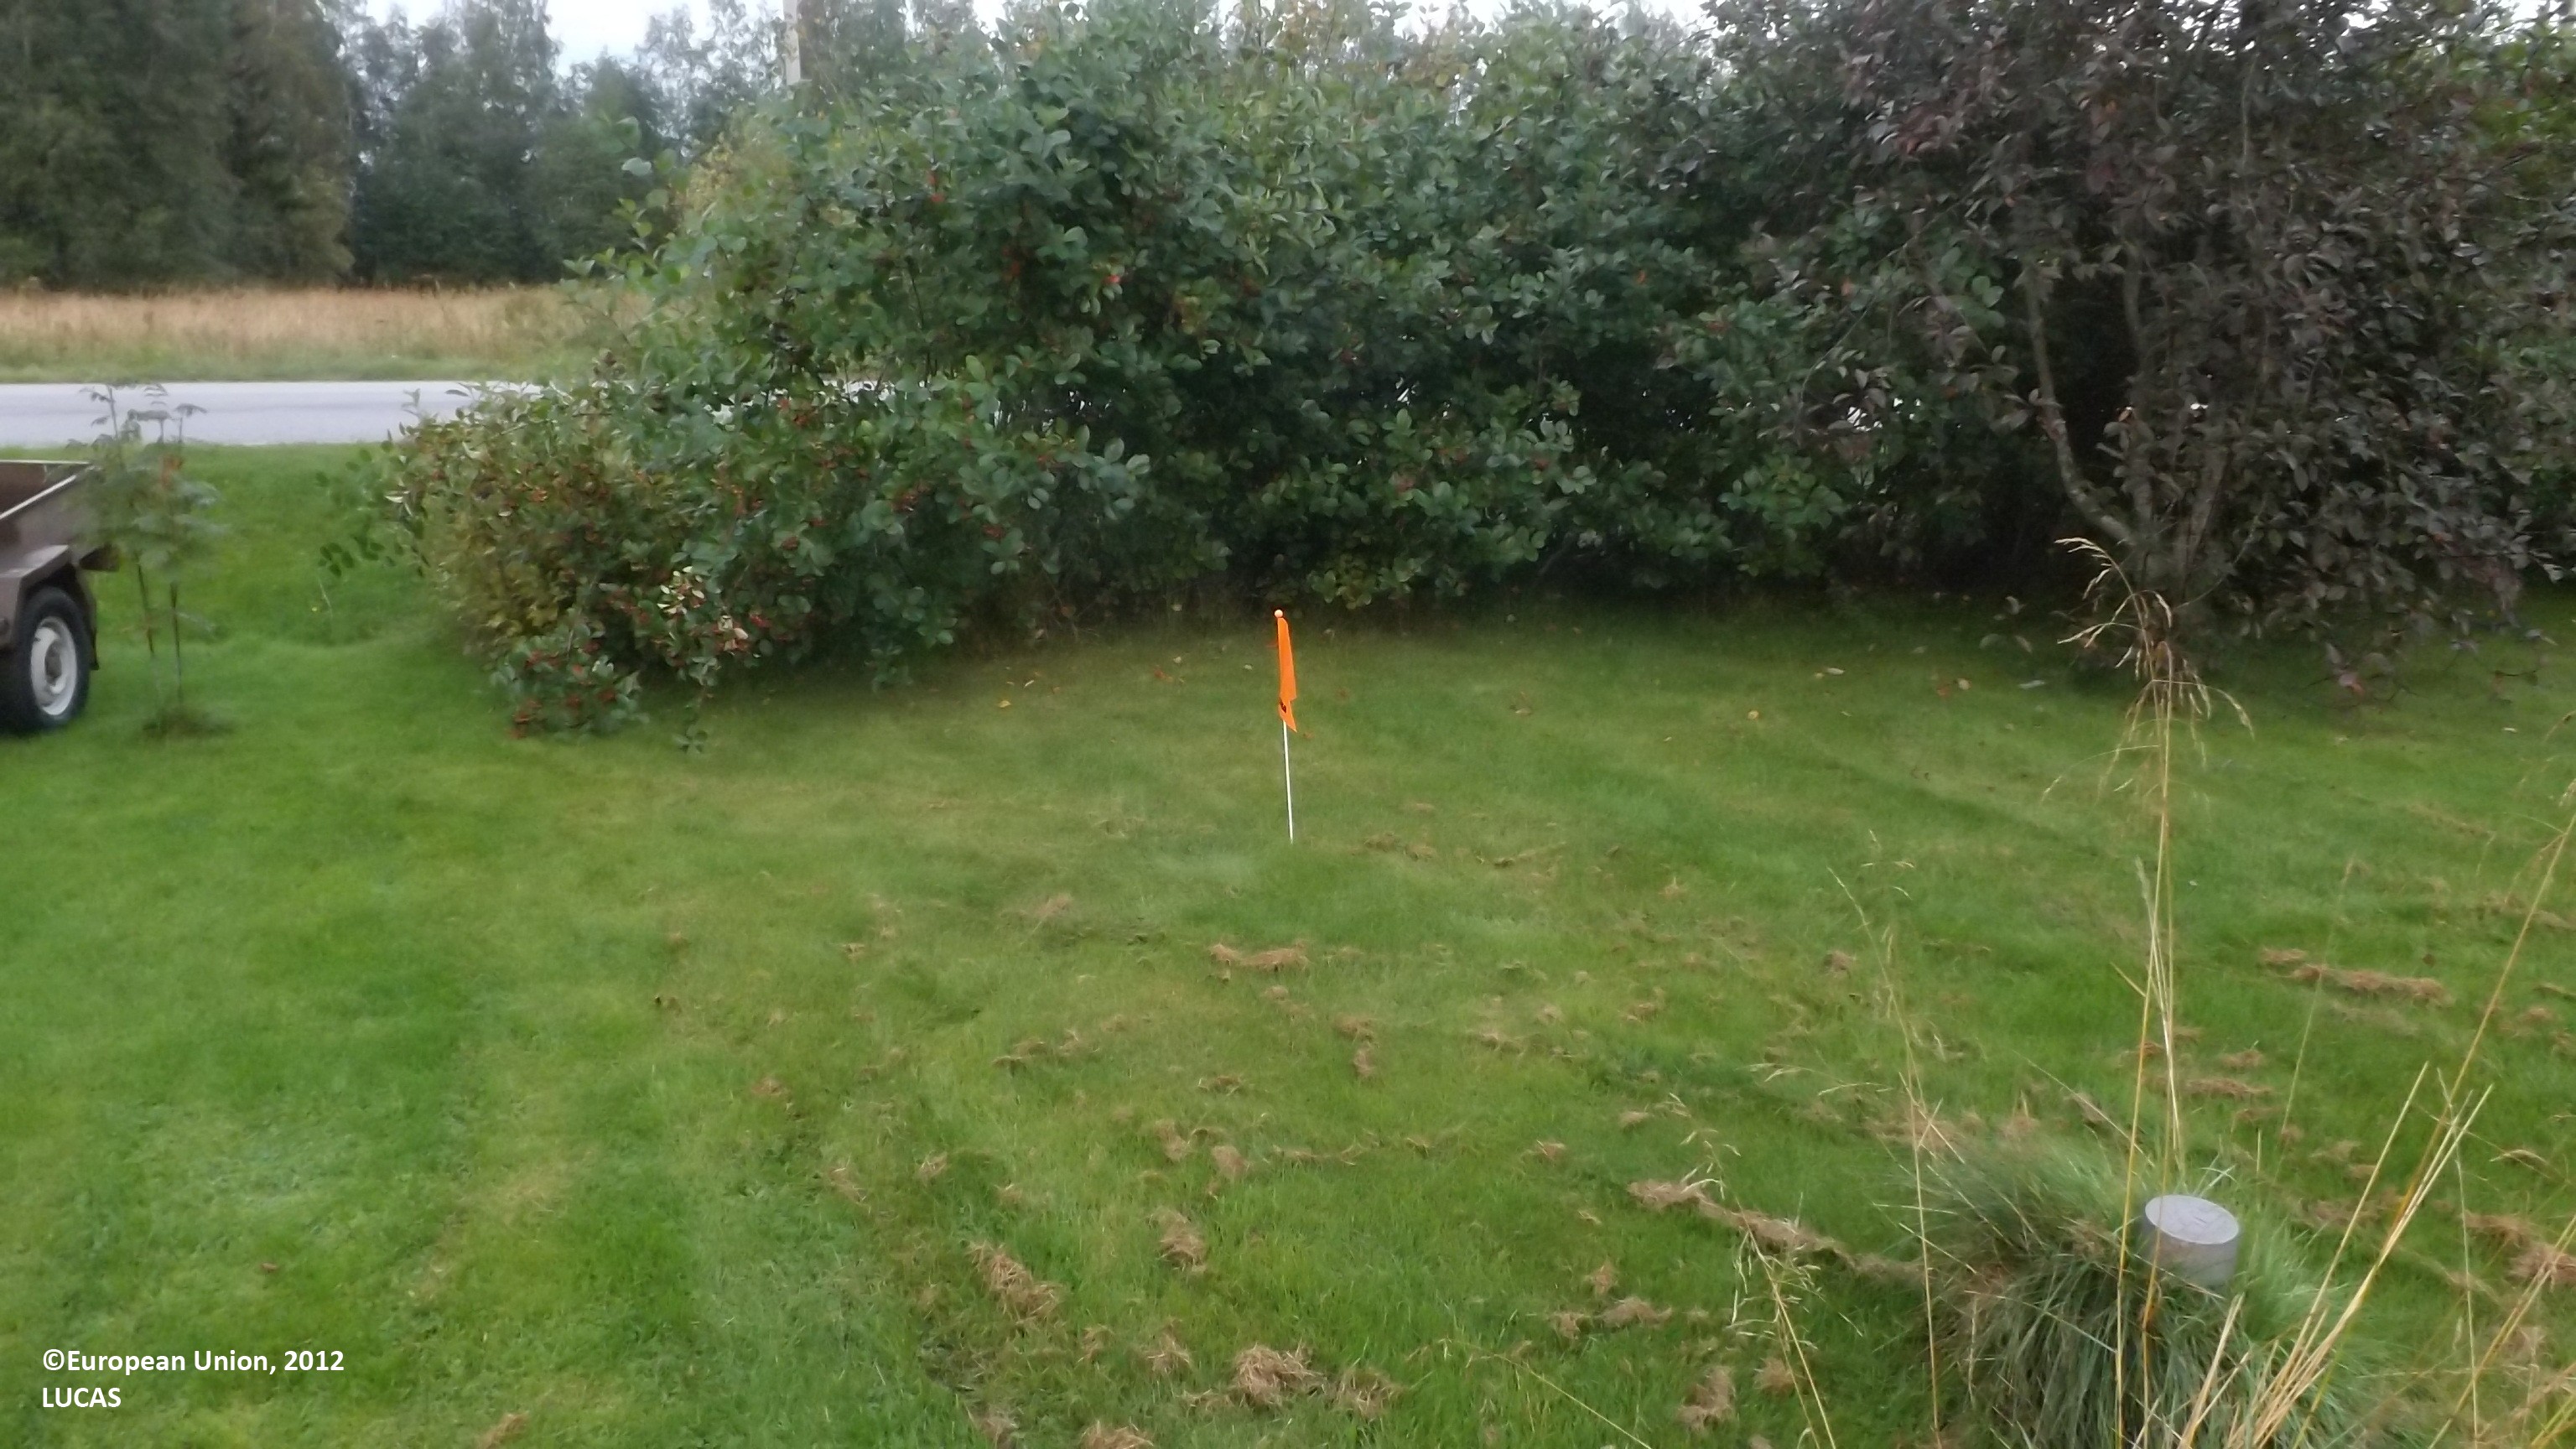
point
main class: Grassland
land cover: Grassland with sparse tree/shrub cover
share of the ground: 10 - 25 %
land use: Residential
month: August
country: FI
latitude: 63.9111
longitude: 23.9034
